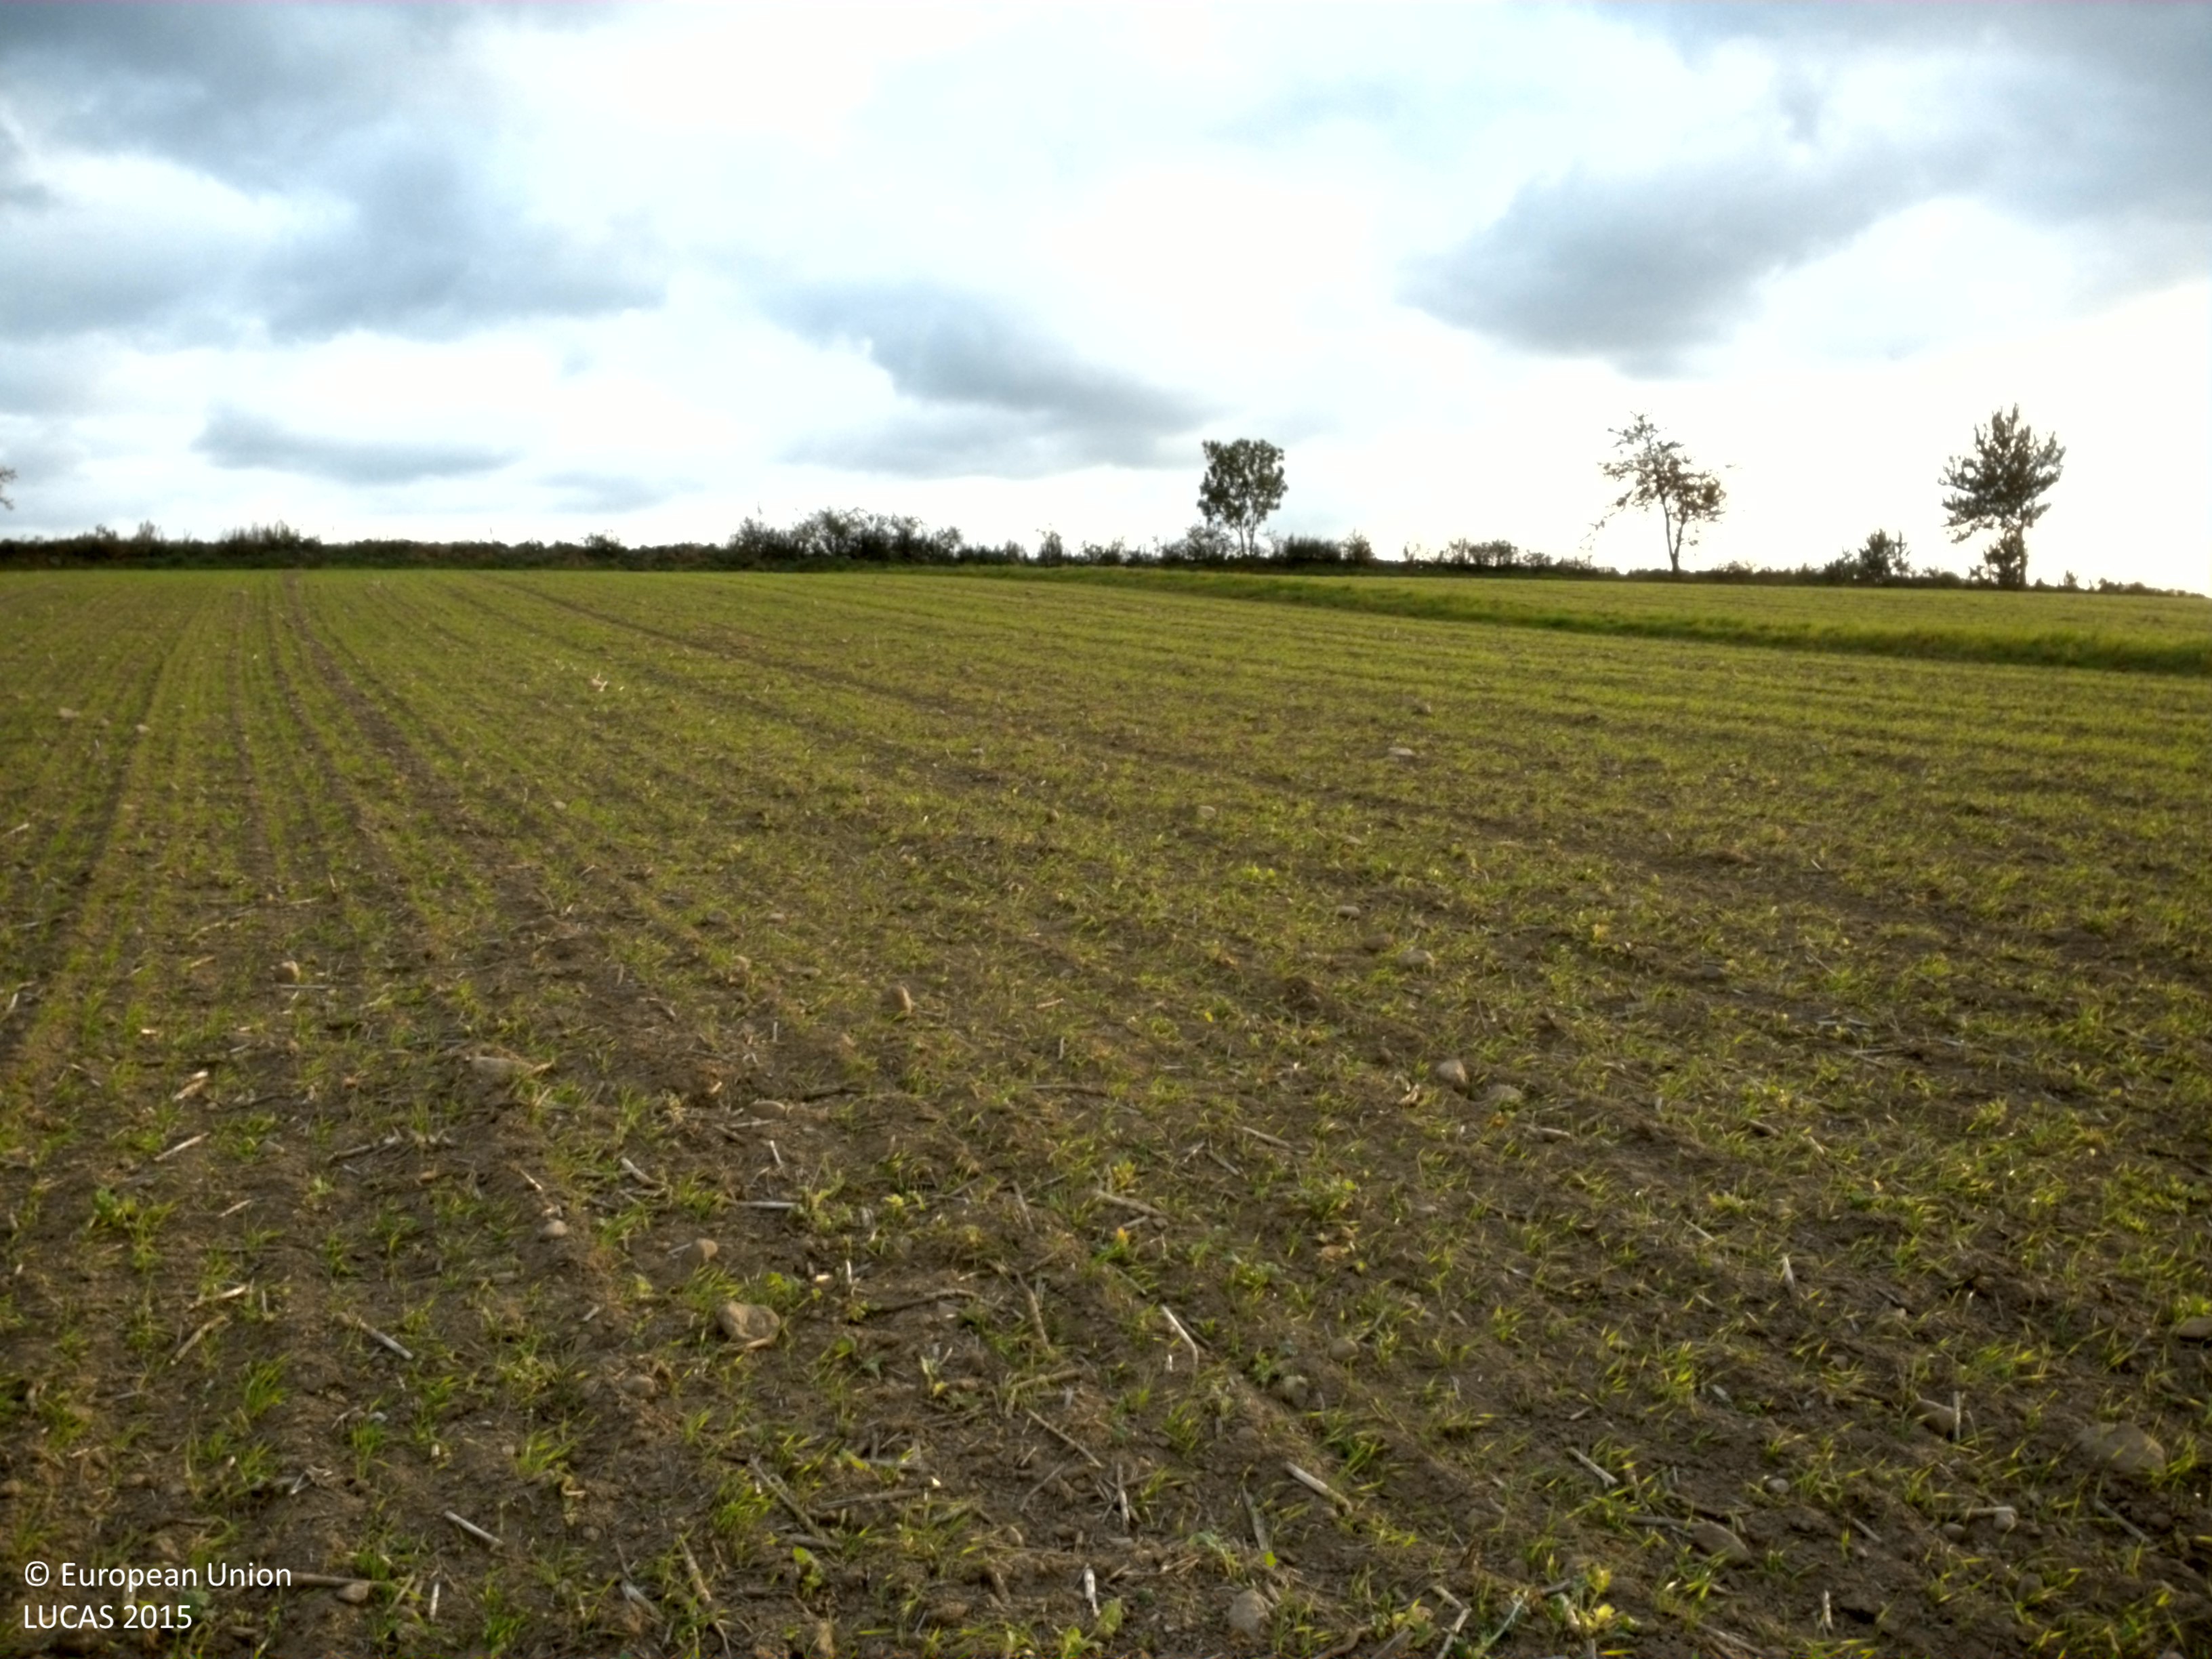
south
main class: Cropland
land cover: Temporary grasslands
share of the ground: 10 - 25 %
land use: Agriculture (excluding fallow land and kitchen gardens)
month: October
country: SE
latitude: 55.6876
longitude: 14.1819
